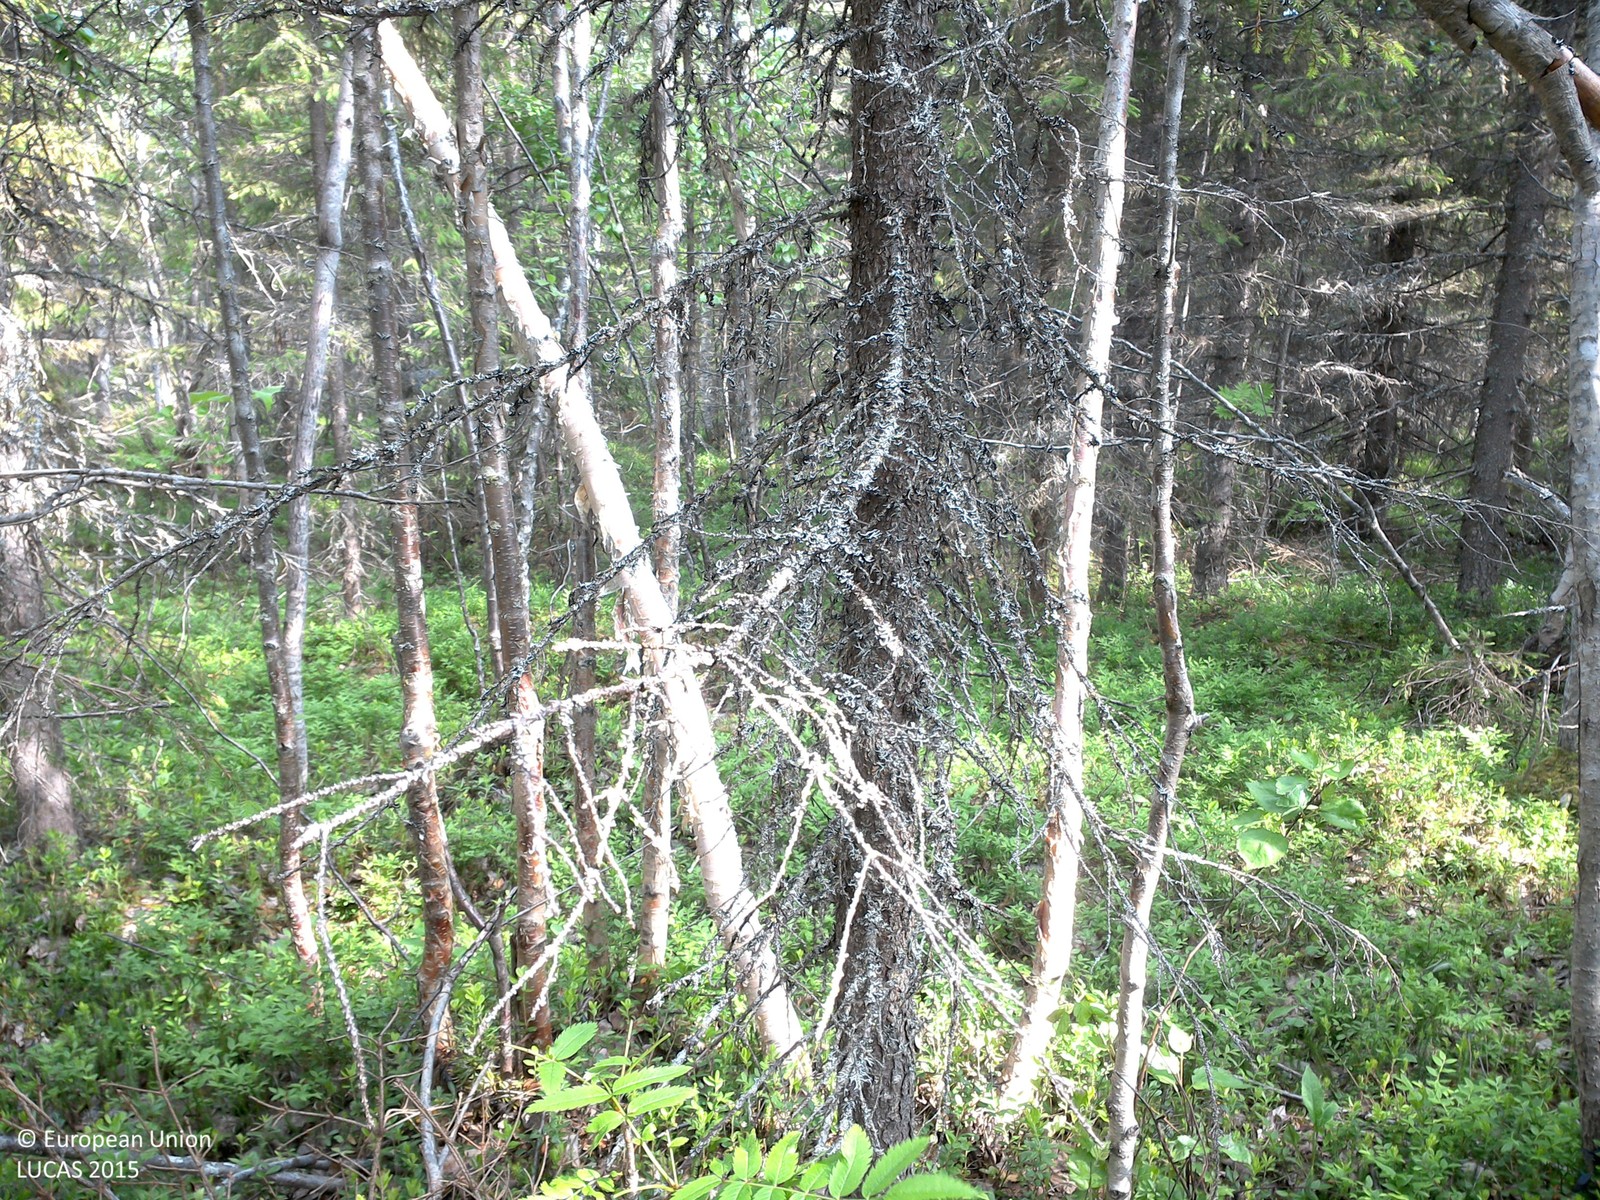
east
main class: Woodland
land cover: Spruce dominated mixed woodland
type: boreal forest
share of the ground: 10 - 25 %
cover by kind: shrubs 55 %, coniferous forest trees 30 %, broadleaved forest trees 15 %
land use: Forestry
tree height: > 5 m
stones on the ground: < 10 %
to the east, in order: Spruce dominated mixed woodland; Ditches and canals; Spruce dominated mixed woodland
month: July
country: SE
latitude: 66.8483
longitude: 23.5874
